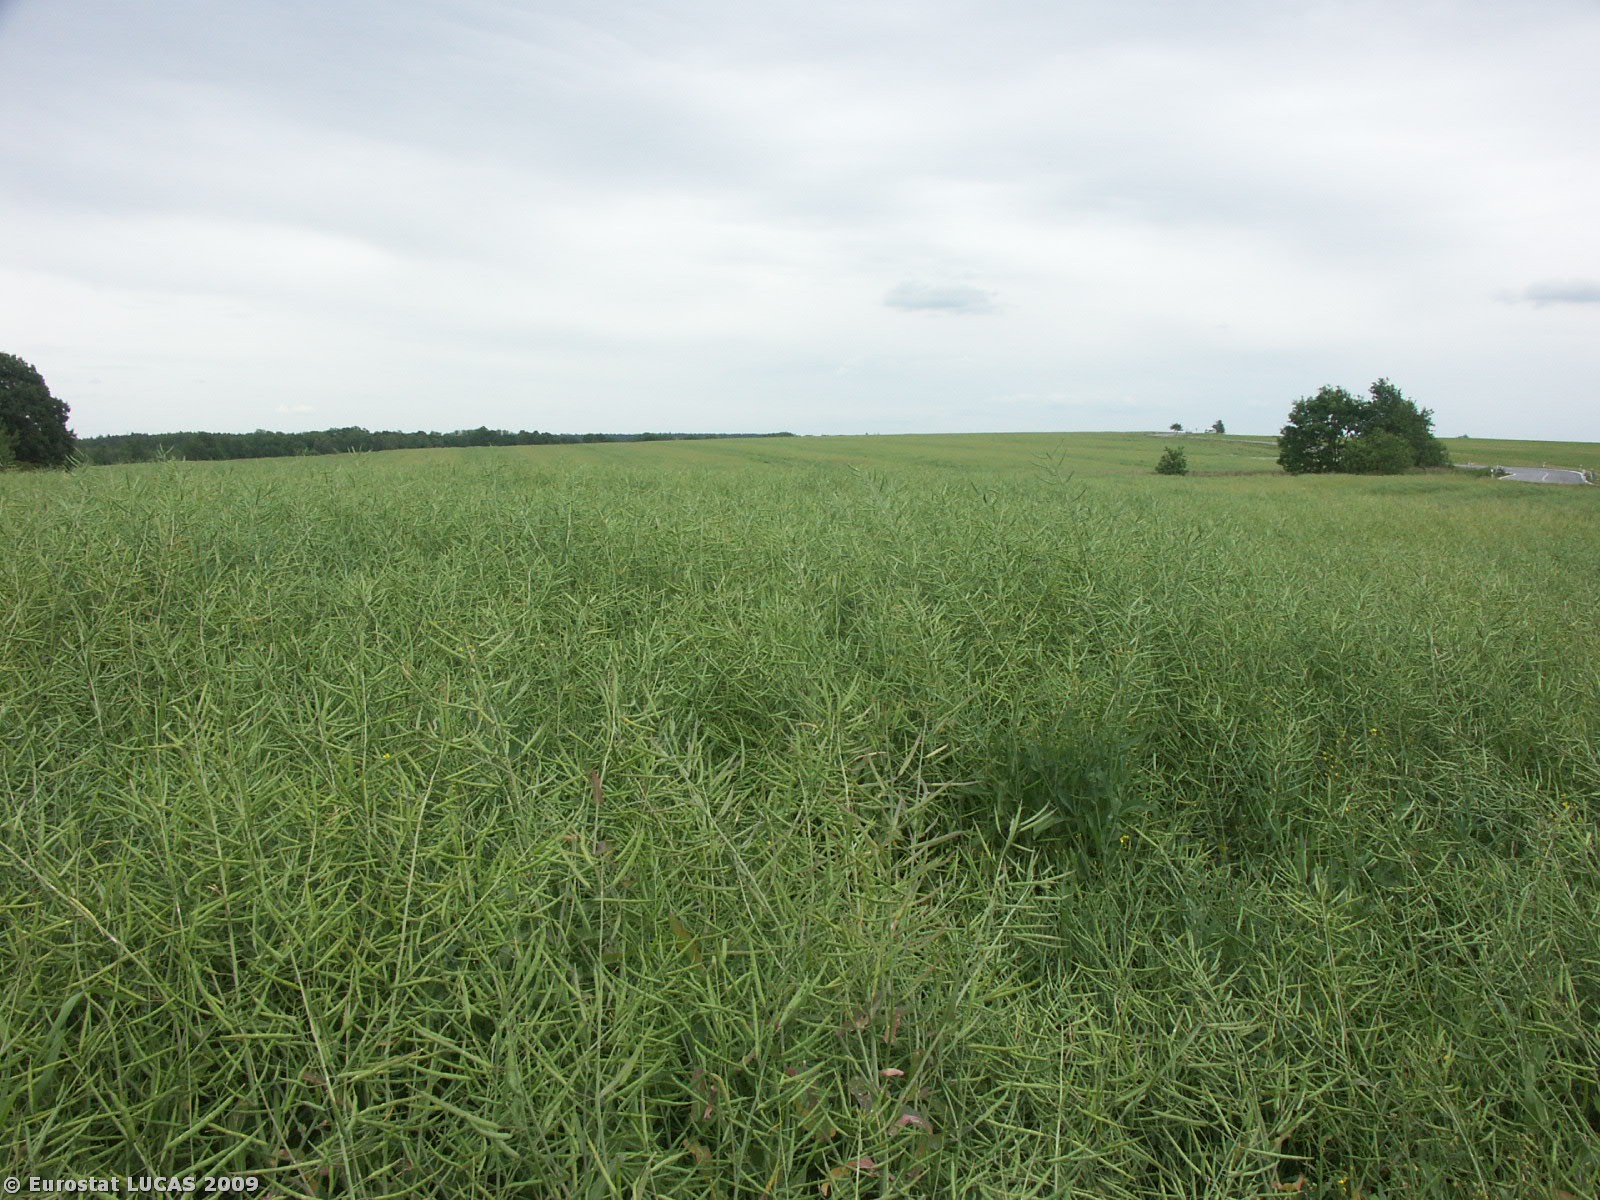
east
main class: Cropland
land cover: Rape and turnip rape
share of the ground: > 75 %
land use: Agriculture (excluding fallow land and kitchen gardens)
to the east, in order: Rape and turnip rape; Grass margins; Rivers and streams; Grassland without tree/shrub cover; Broadleaved woodland; Rape and turnip rape
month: June
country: CZ
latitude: 49.0091
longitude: 14.6360
